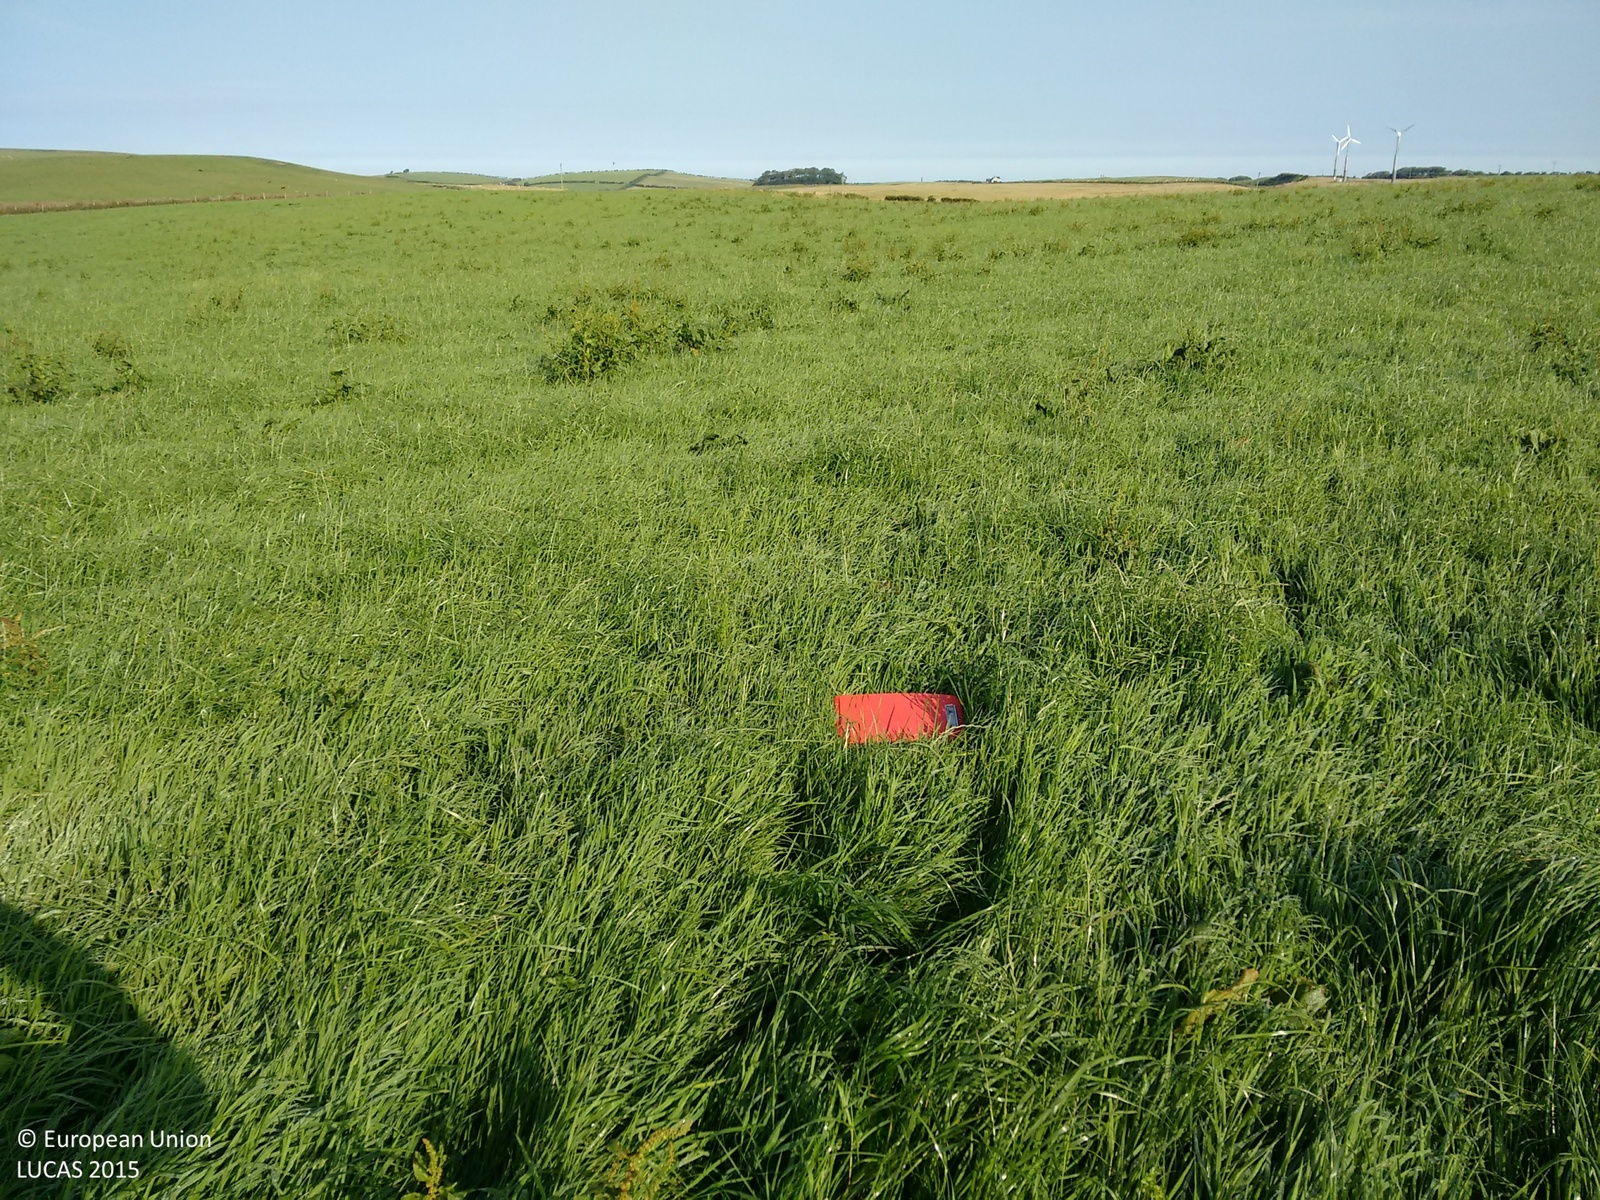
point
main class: Grassland
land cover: Grassland without tree/shrub cover
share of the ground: > 75 %
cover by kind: herbaceous plants 100 %
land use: Agriculture (excluding fallow land and kitchen gardens)
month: August
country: GB
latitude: 54.9052
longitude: -5.0723
